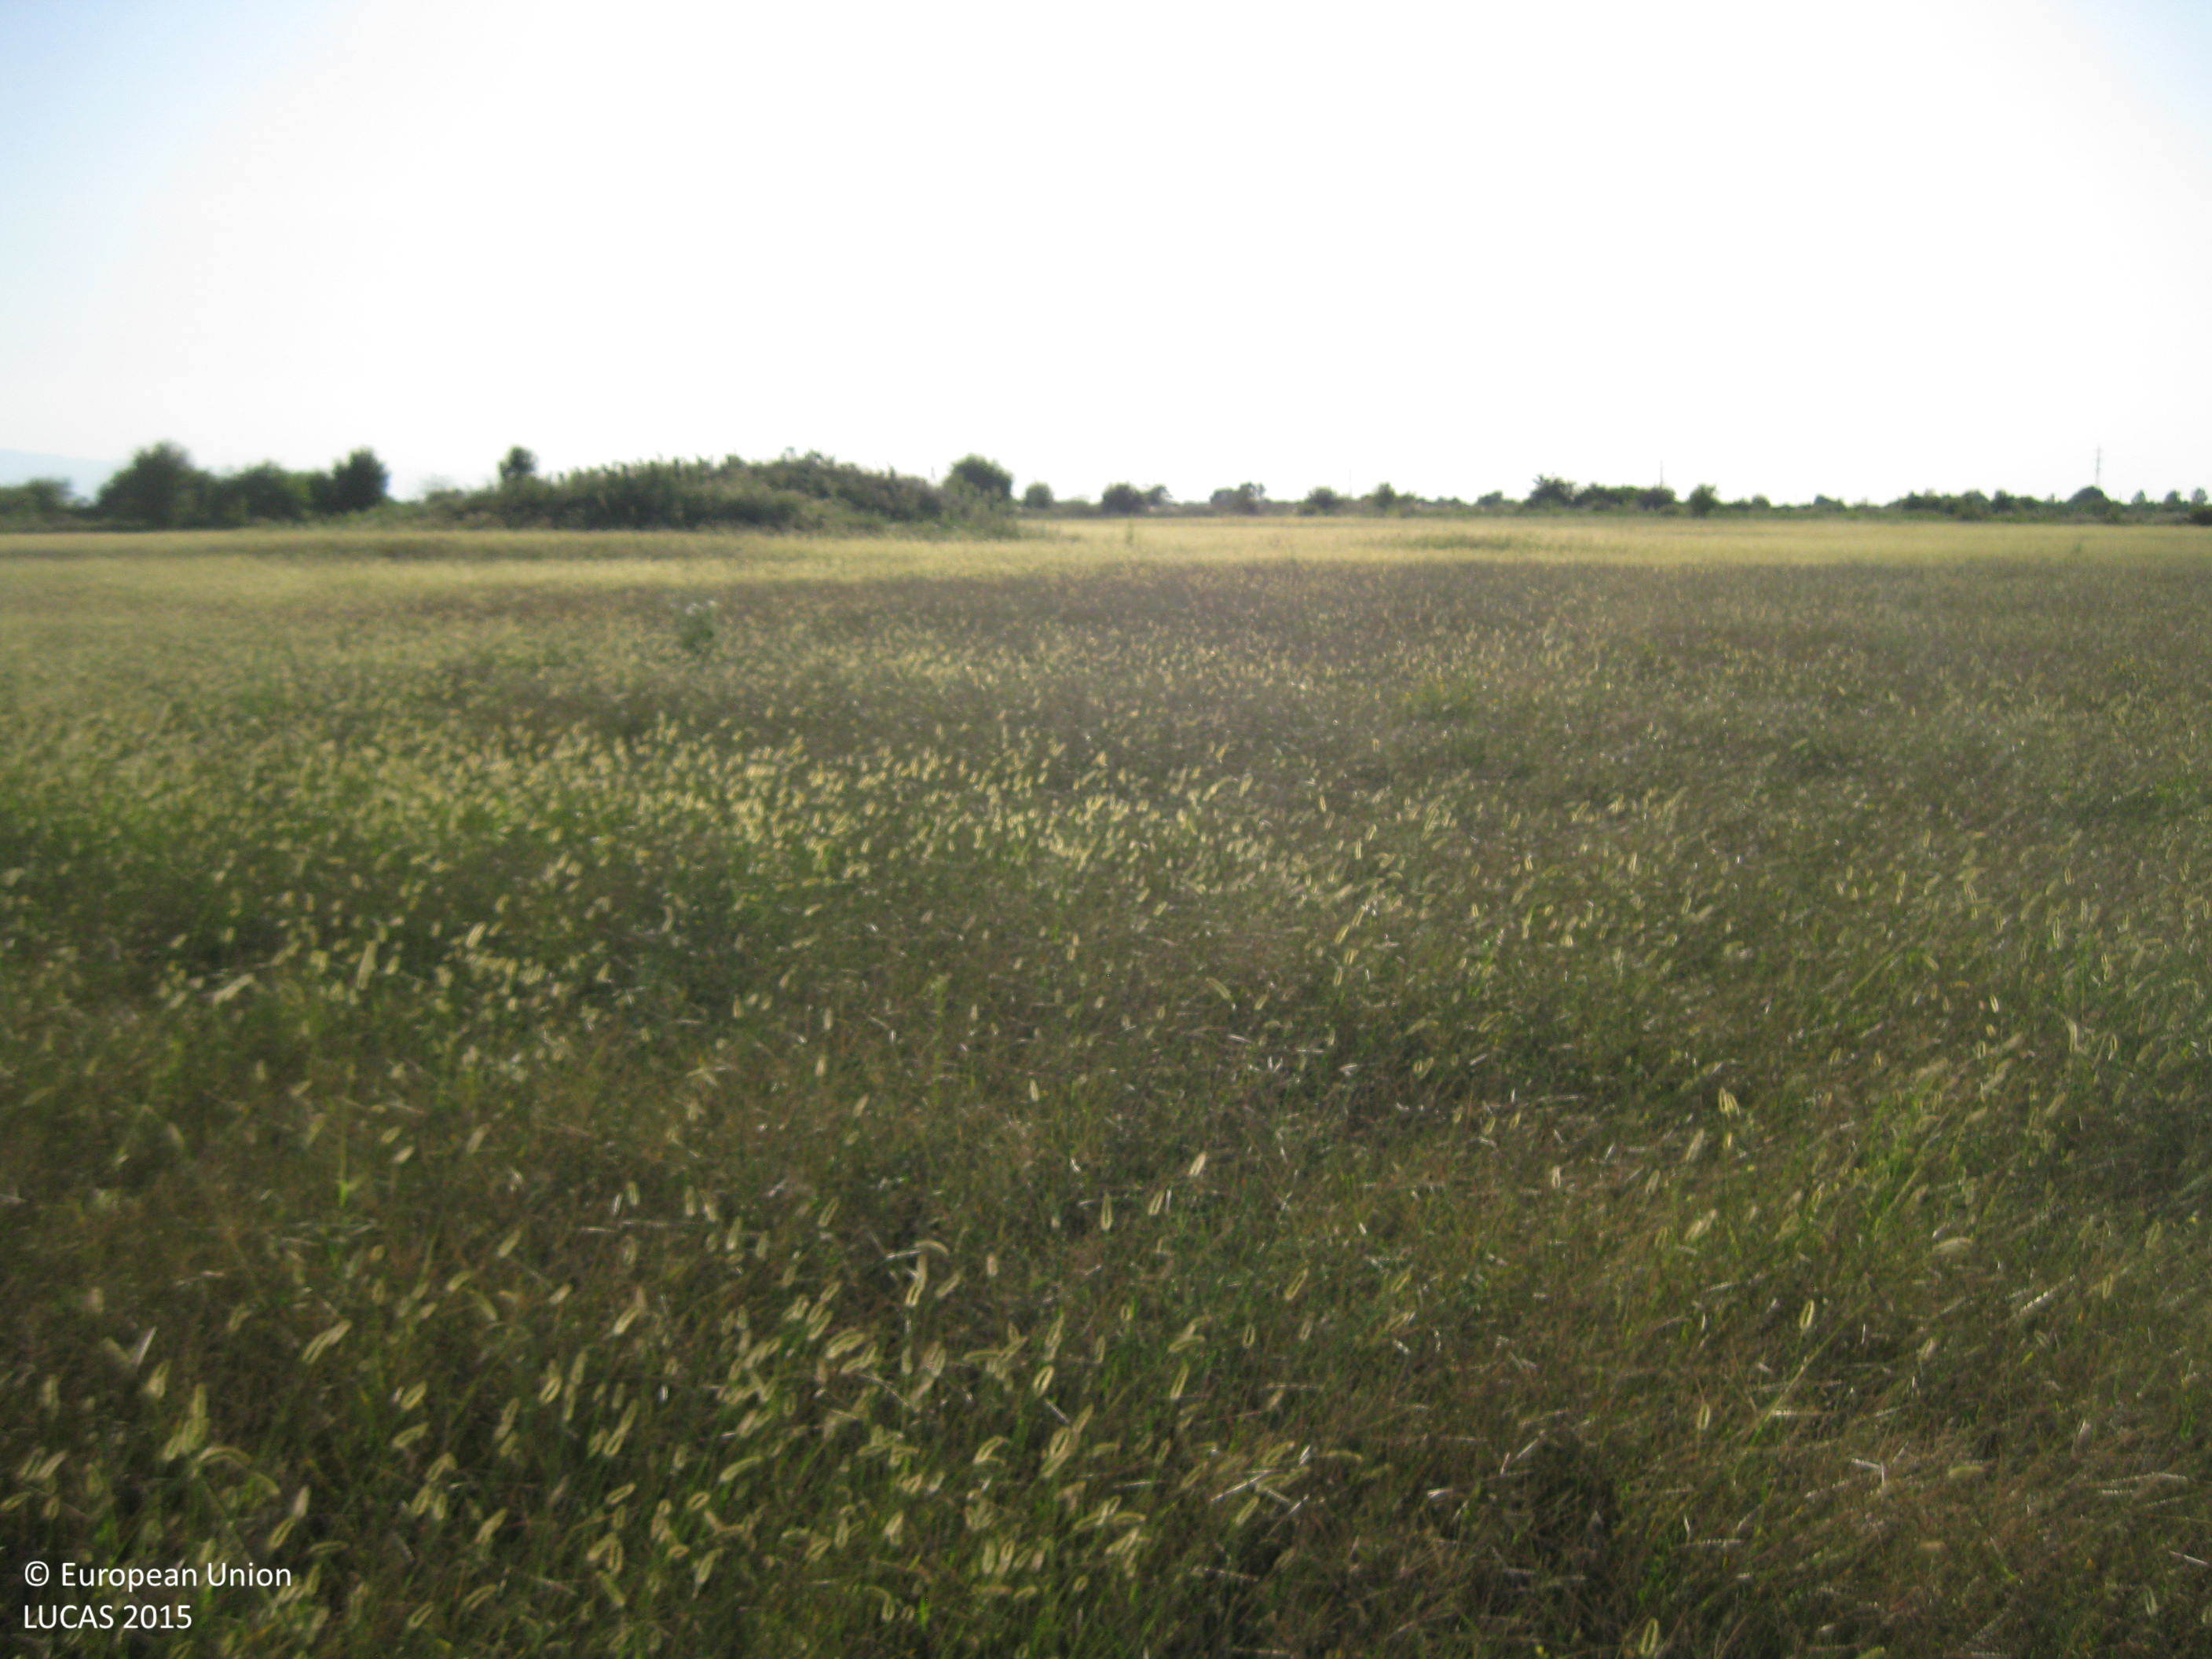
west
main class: Cropland
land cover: Mixed cereals for fodder
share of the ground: 25 - 50 %
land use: Agriculture (excluding fallow land and kitchen gardens)
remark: Harvested field
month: August
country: BG
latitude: 42.2094
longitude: 24.9915
